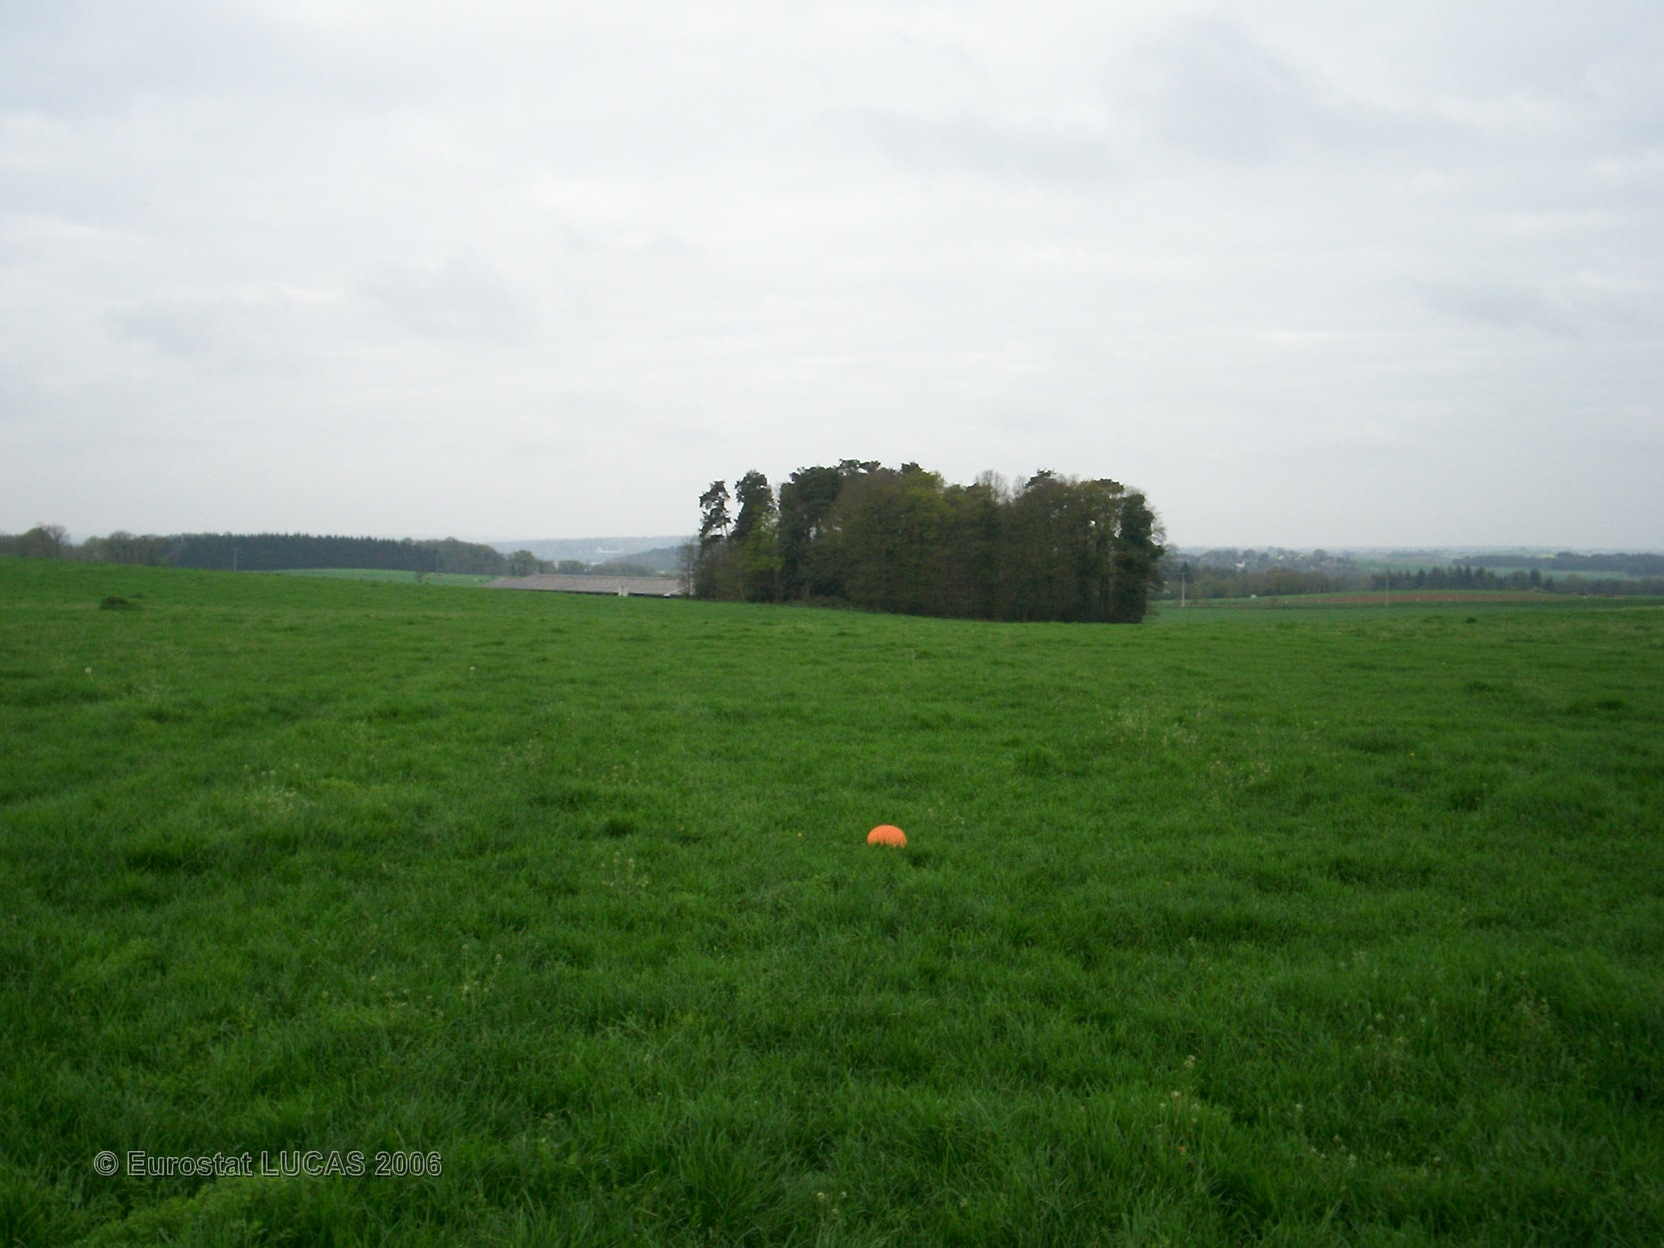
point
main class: Grassland
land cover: Grassland without tree/shrub cover
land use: Agriculture (excluding fallow land and kitchen gardens)
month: April
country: FR
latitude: 47.9788
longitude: -2.3694
